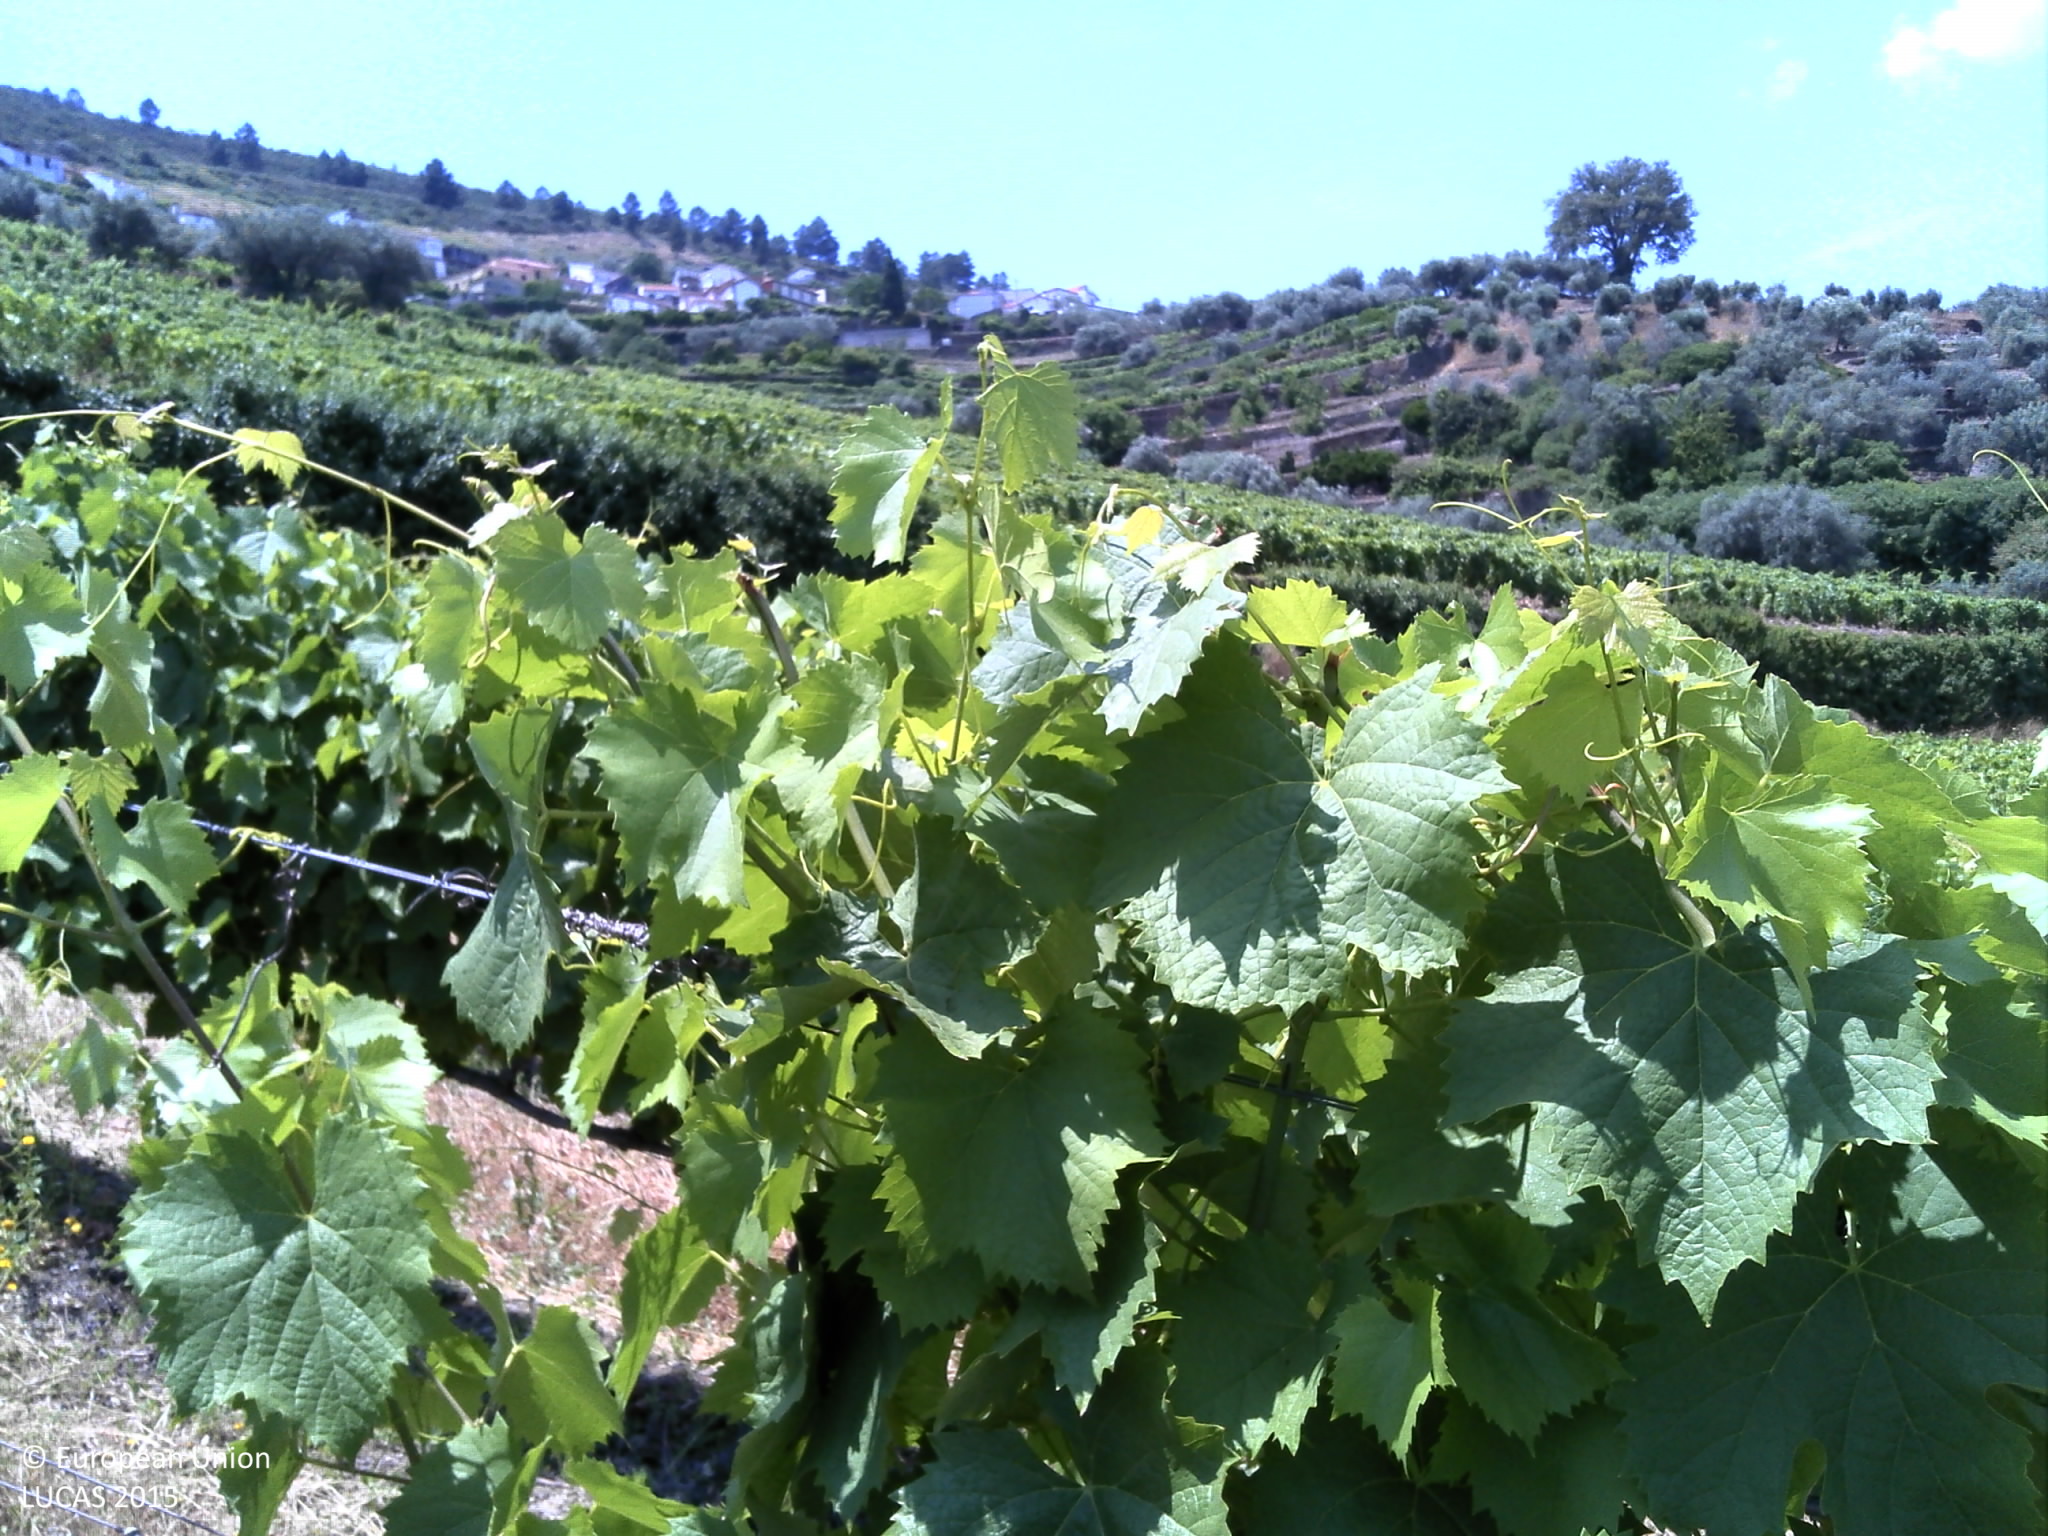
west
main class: Cropland
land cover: Vineyards
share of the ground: 10 - 25 %
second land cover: Spontaneously vegetated surfaces
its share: 50 - 75 %
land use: Agriculture (excluding fallow land and kitchen gardens)
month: June
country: PT
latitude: 41.1963
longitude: -7.5689
